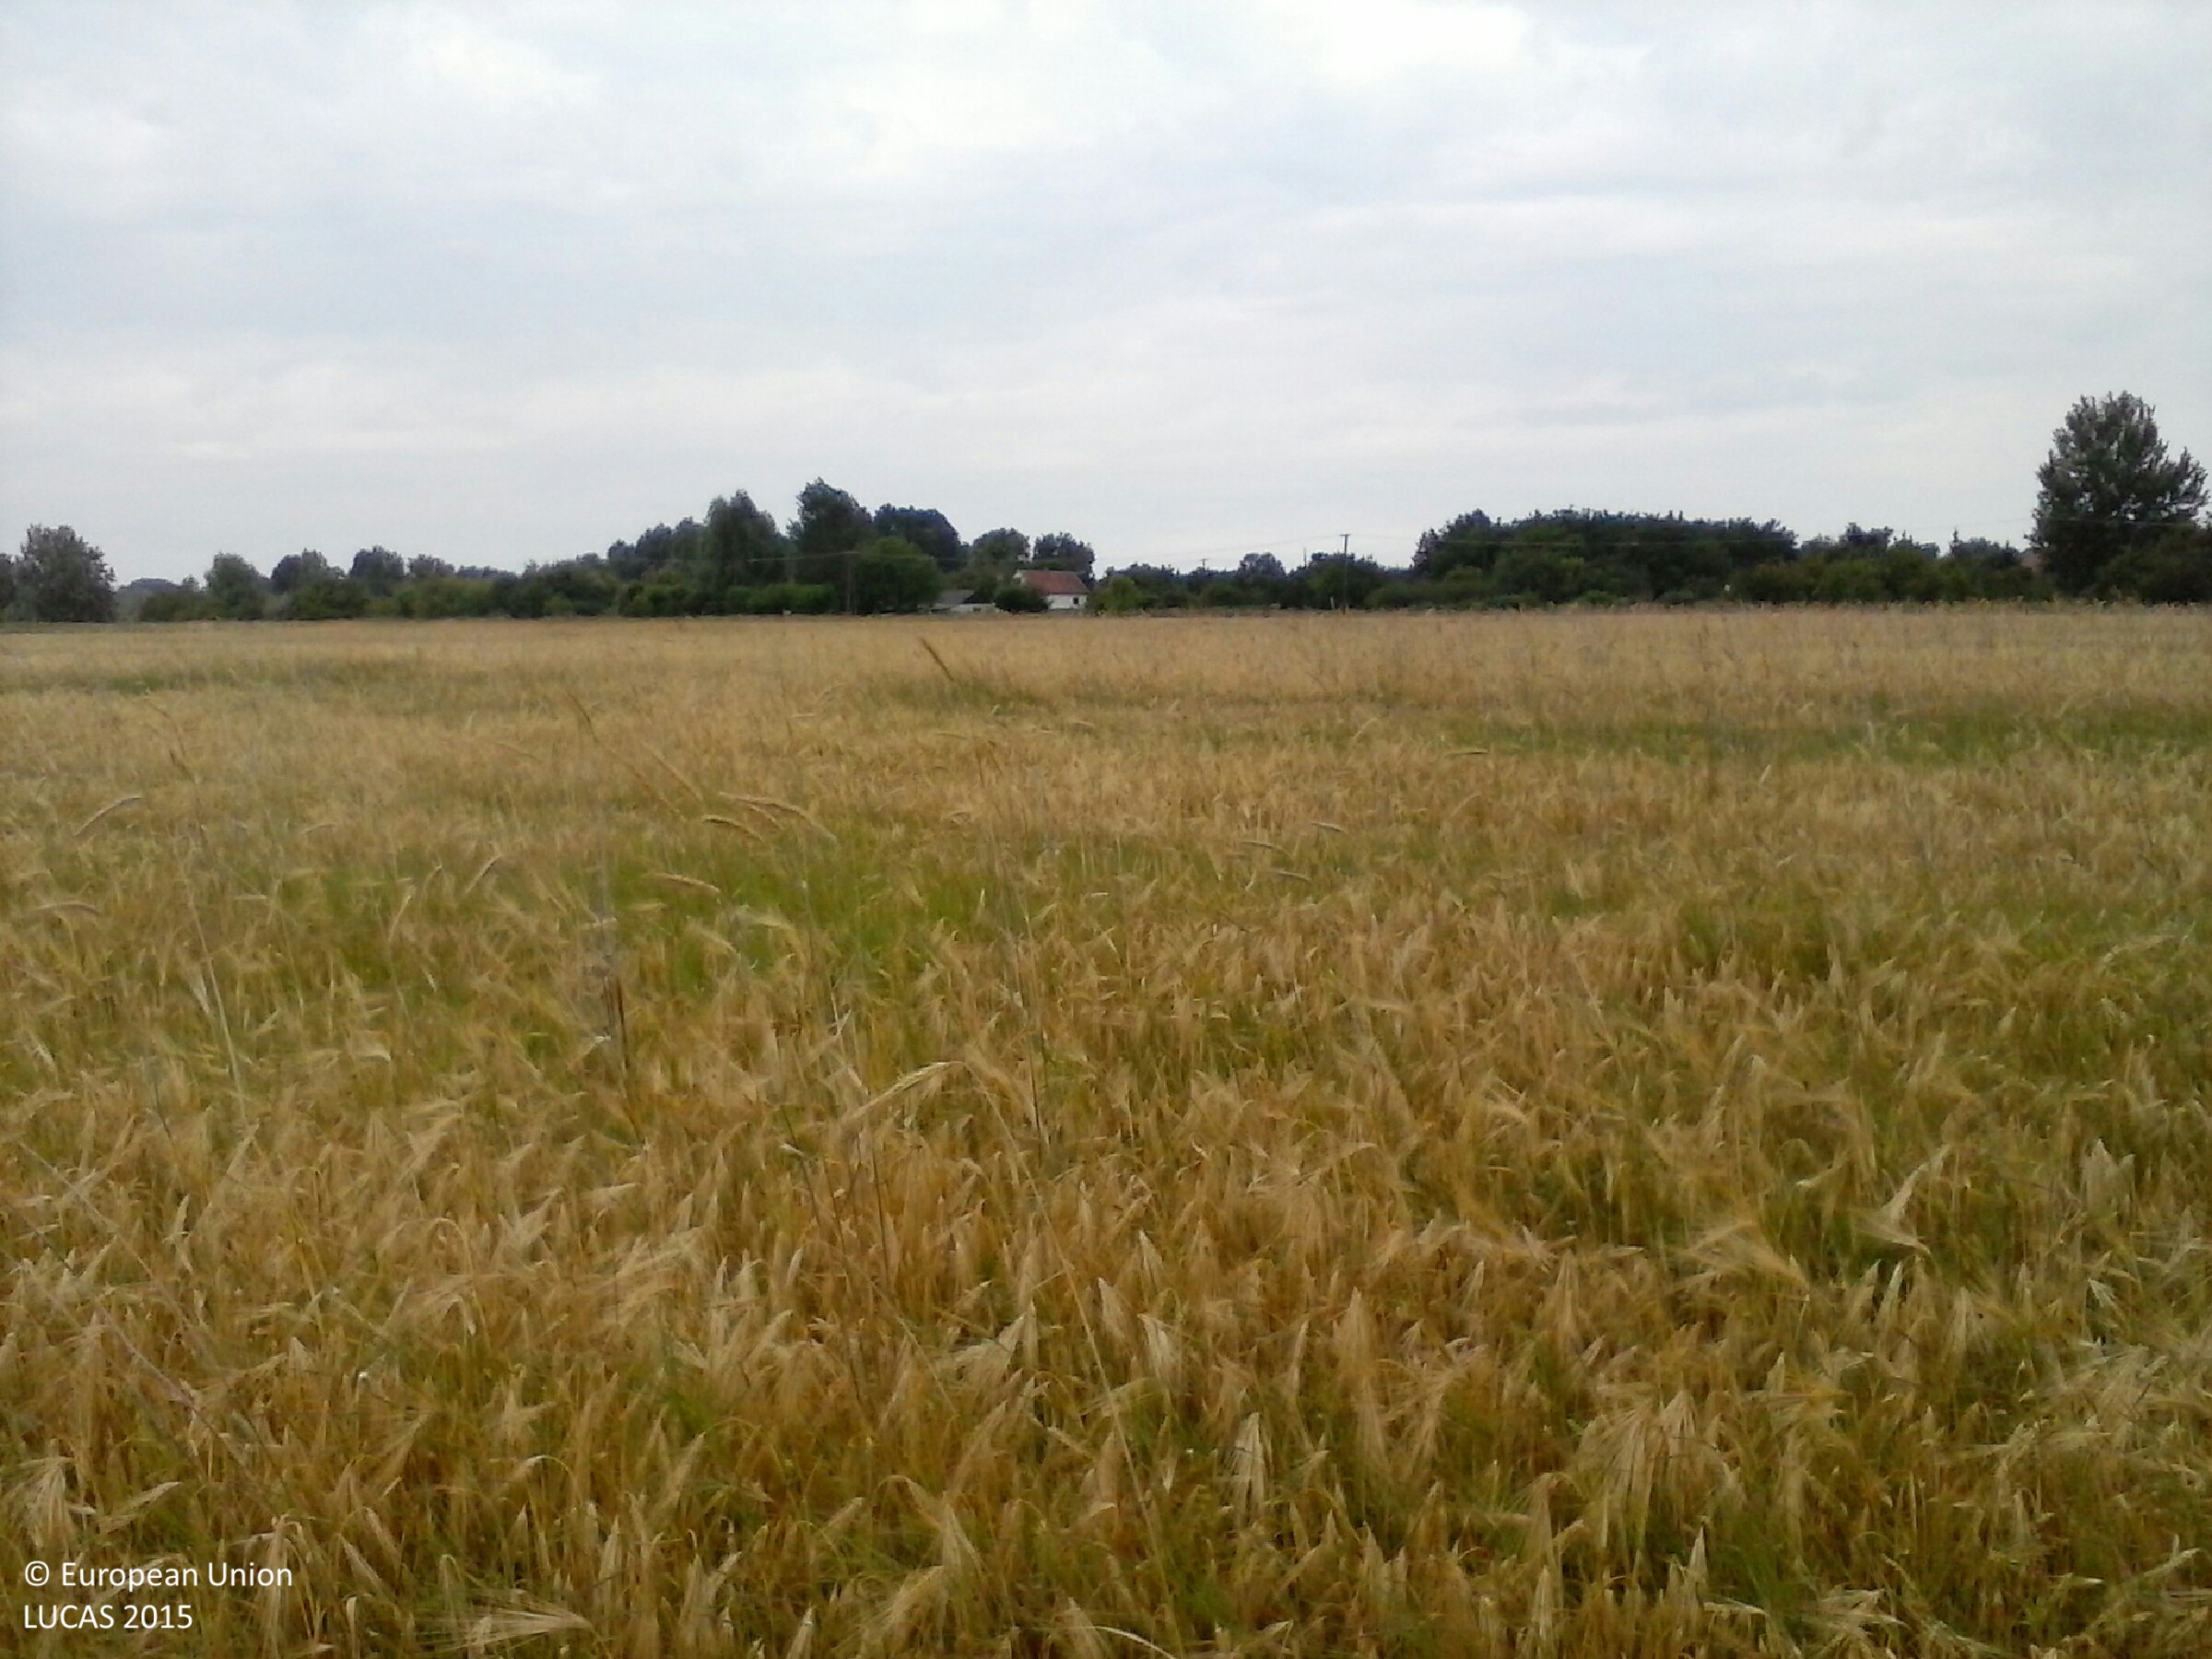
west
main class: Cropland
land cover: Barley
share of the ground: > 75 %
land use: Agriculture (excluding fallow land and kitchen gardens)
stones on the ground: < 10 %
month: June
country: HU
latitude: 46.3162
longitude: 20.0076
